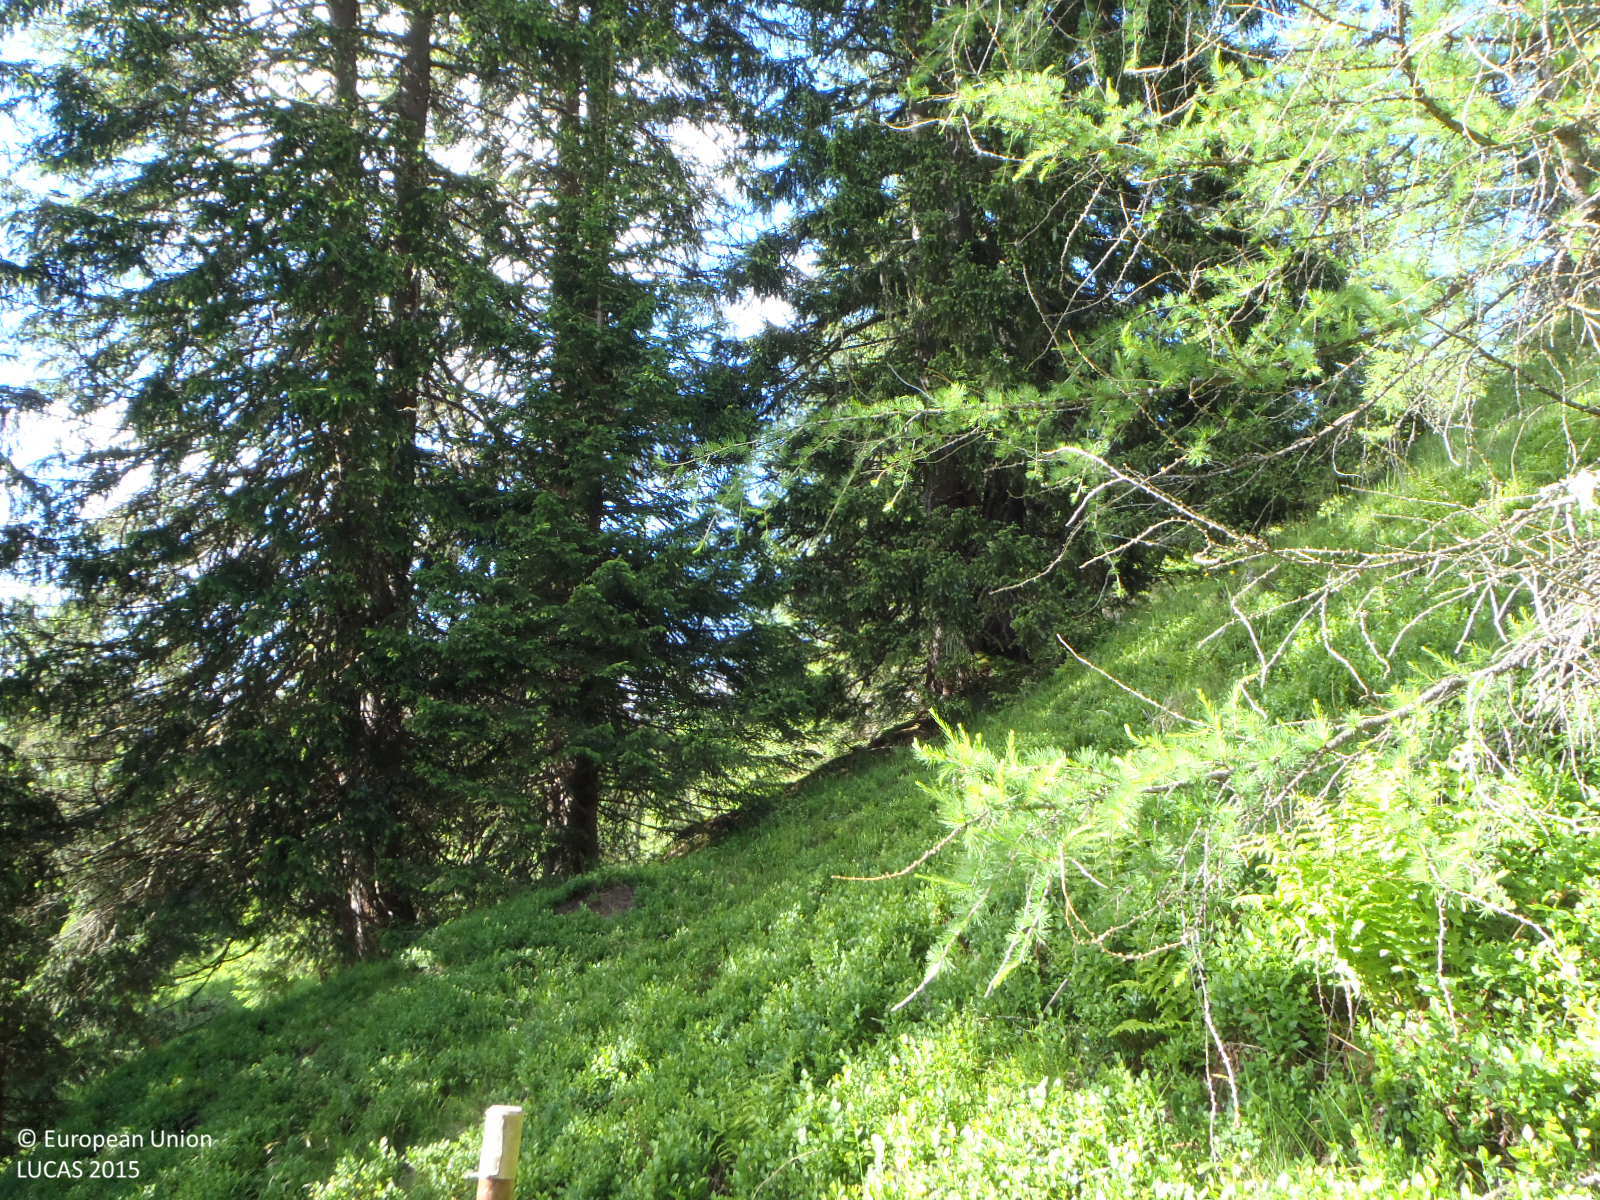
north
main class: Woodland
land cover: Other coniferous woodland
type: alpine coniferous forest
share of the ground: 50 - 75 %
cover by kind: coniferous forest trees 55 %, shrubs 20 %, herbaceous plants 20 %, lichens and mosses 5 %
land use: Forestry
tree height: > 5 m
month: June
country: AT
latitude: 47.3464
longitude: 12.6058
